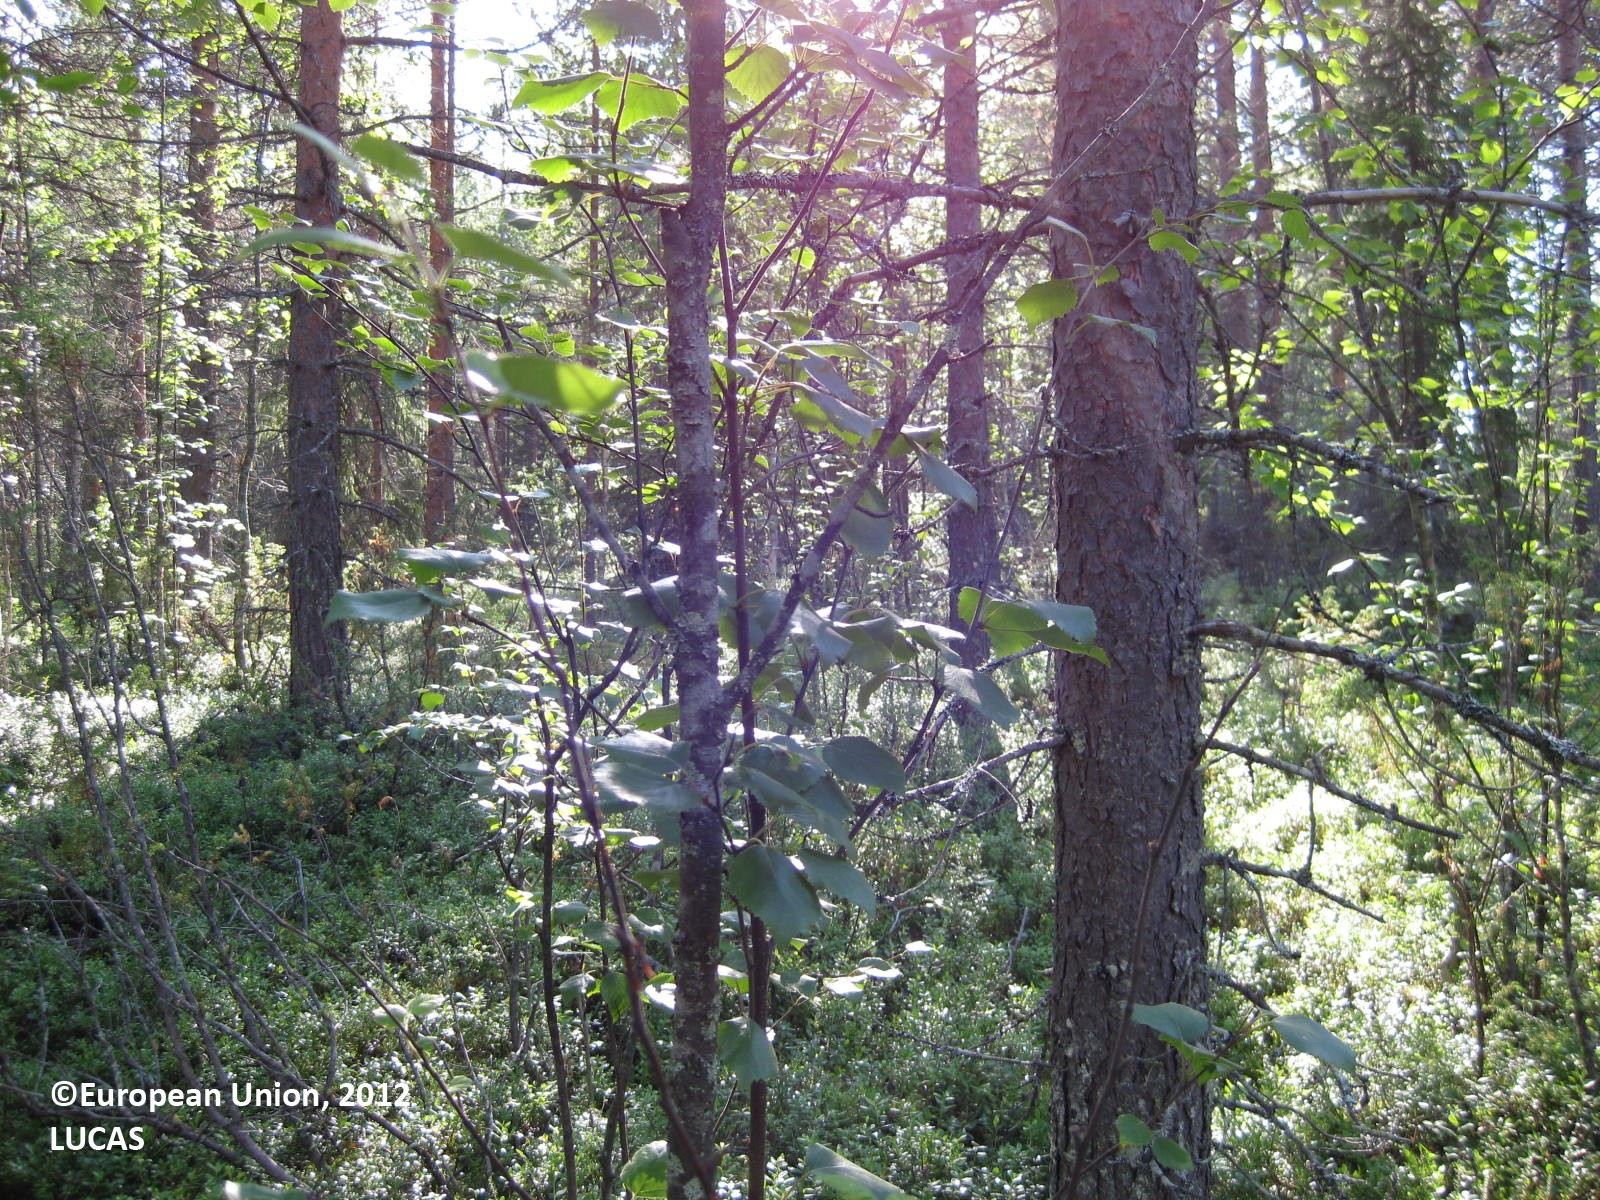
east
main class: Woodland
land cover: Pine dominated mixed woodland
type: boreal forest
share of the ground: > 75 %
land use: Forestry
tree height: > 5 m
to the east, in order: Pine dominated mixed woodland; Shrubland without tree cover; Electric lines; Shrubland without tree cover; Pine dominated mixed woodland; Other coniferous woodland; Electric lines; Broadleaved woodland
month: July
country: FI
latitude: 65.6310
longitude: 28.3336
